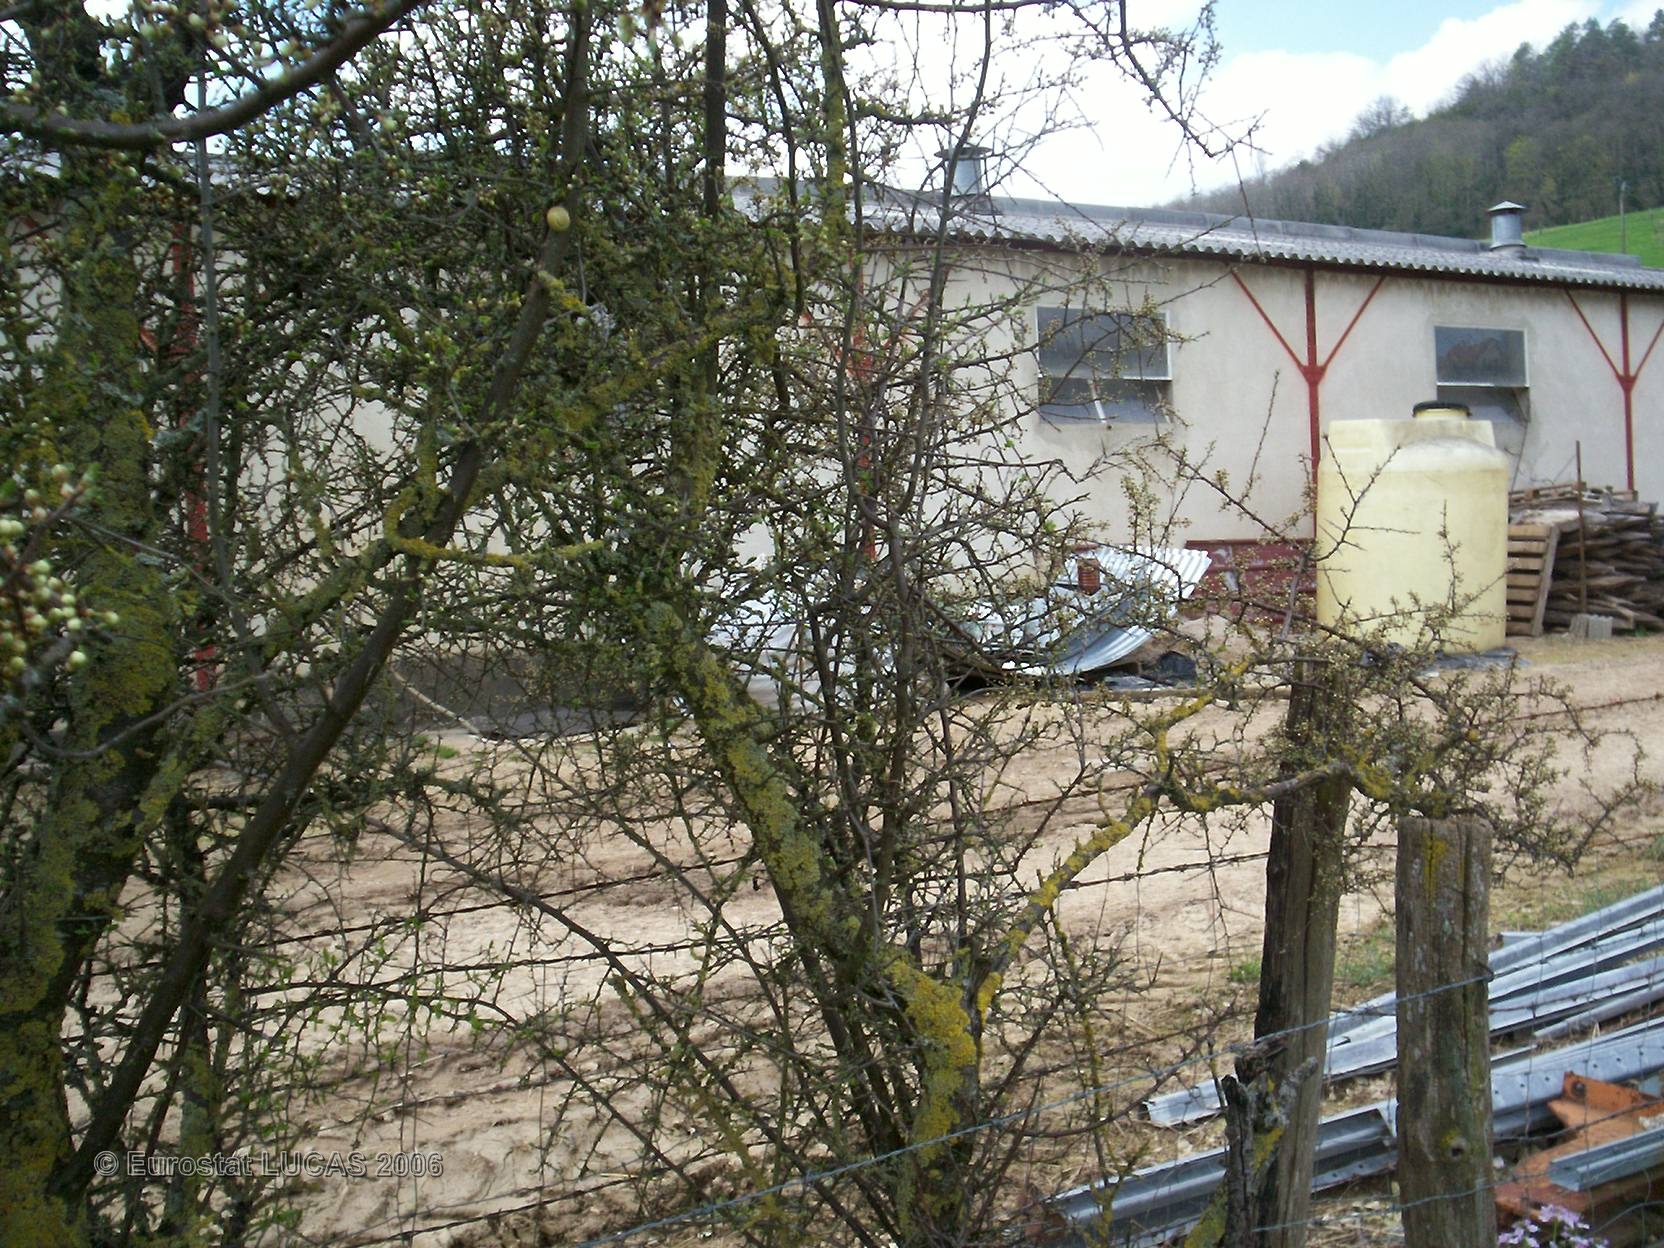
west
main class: Grassland
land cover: Grassland without tree/shrub cover
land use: Agriculture (excluding fallow land and kitchen gardens)
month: April
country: FR
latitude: 47.5484
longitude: 4.5646
